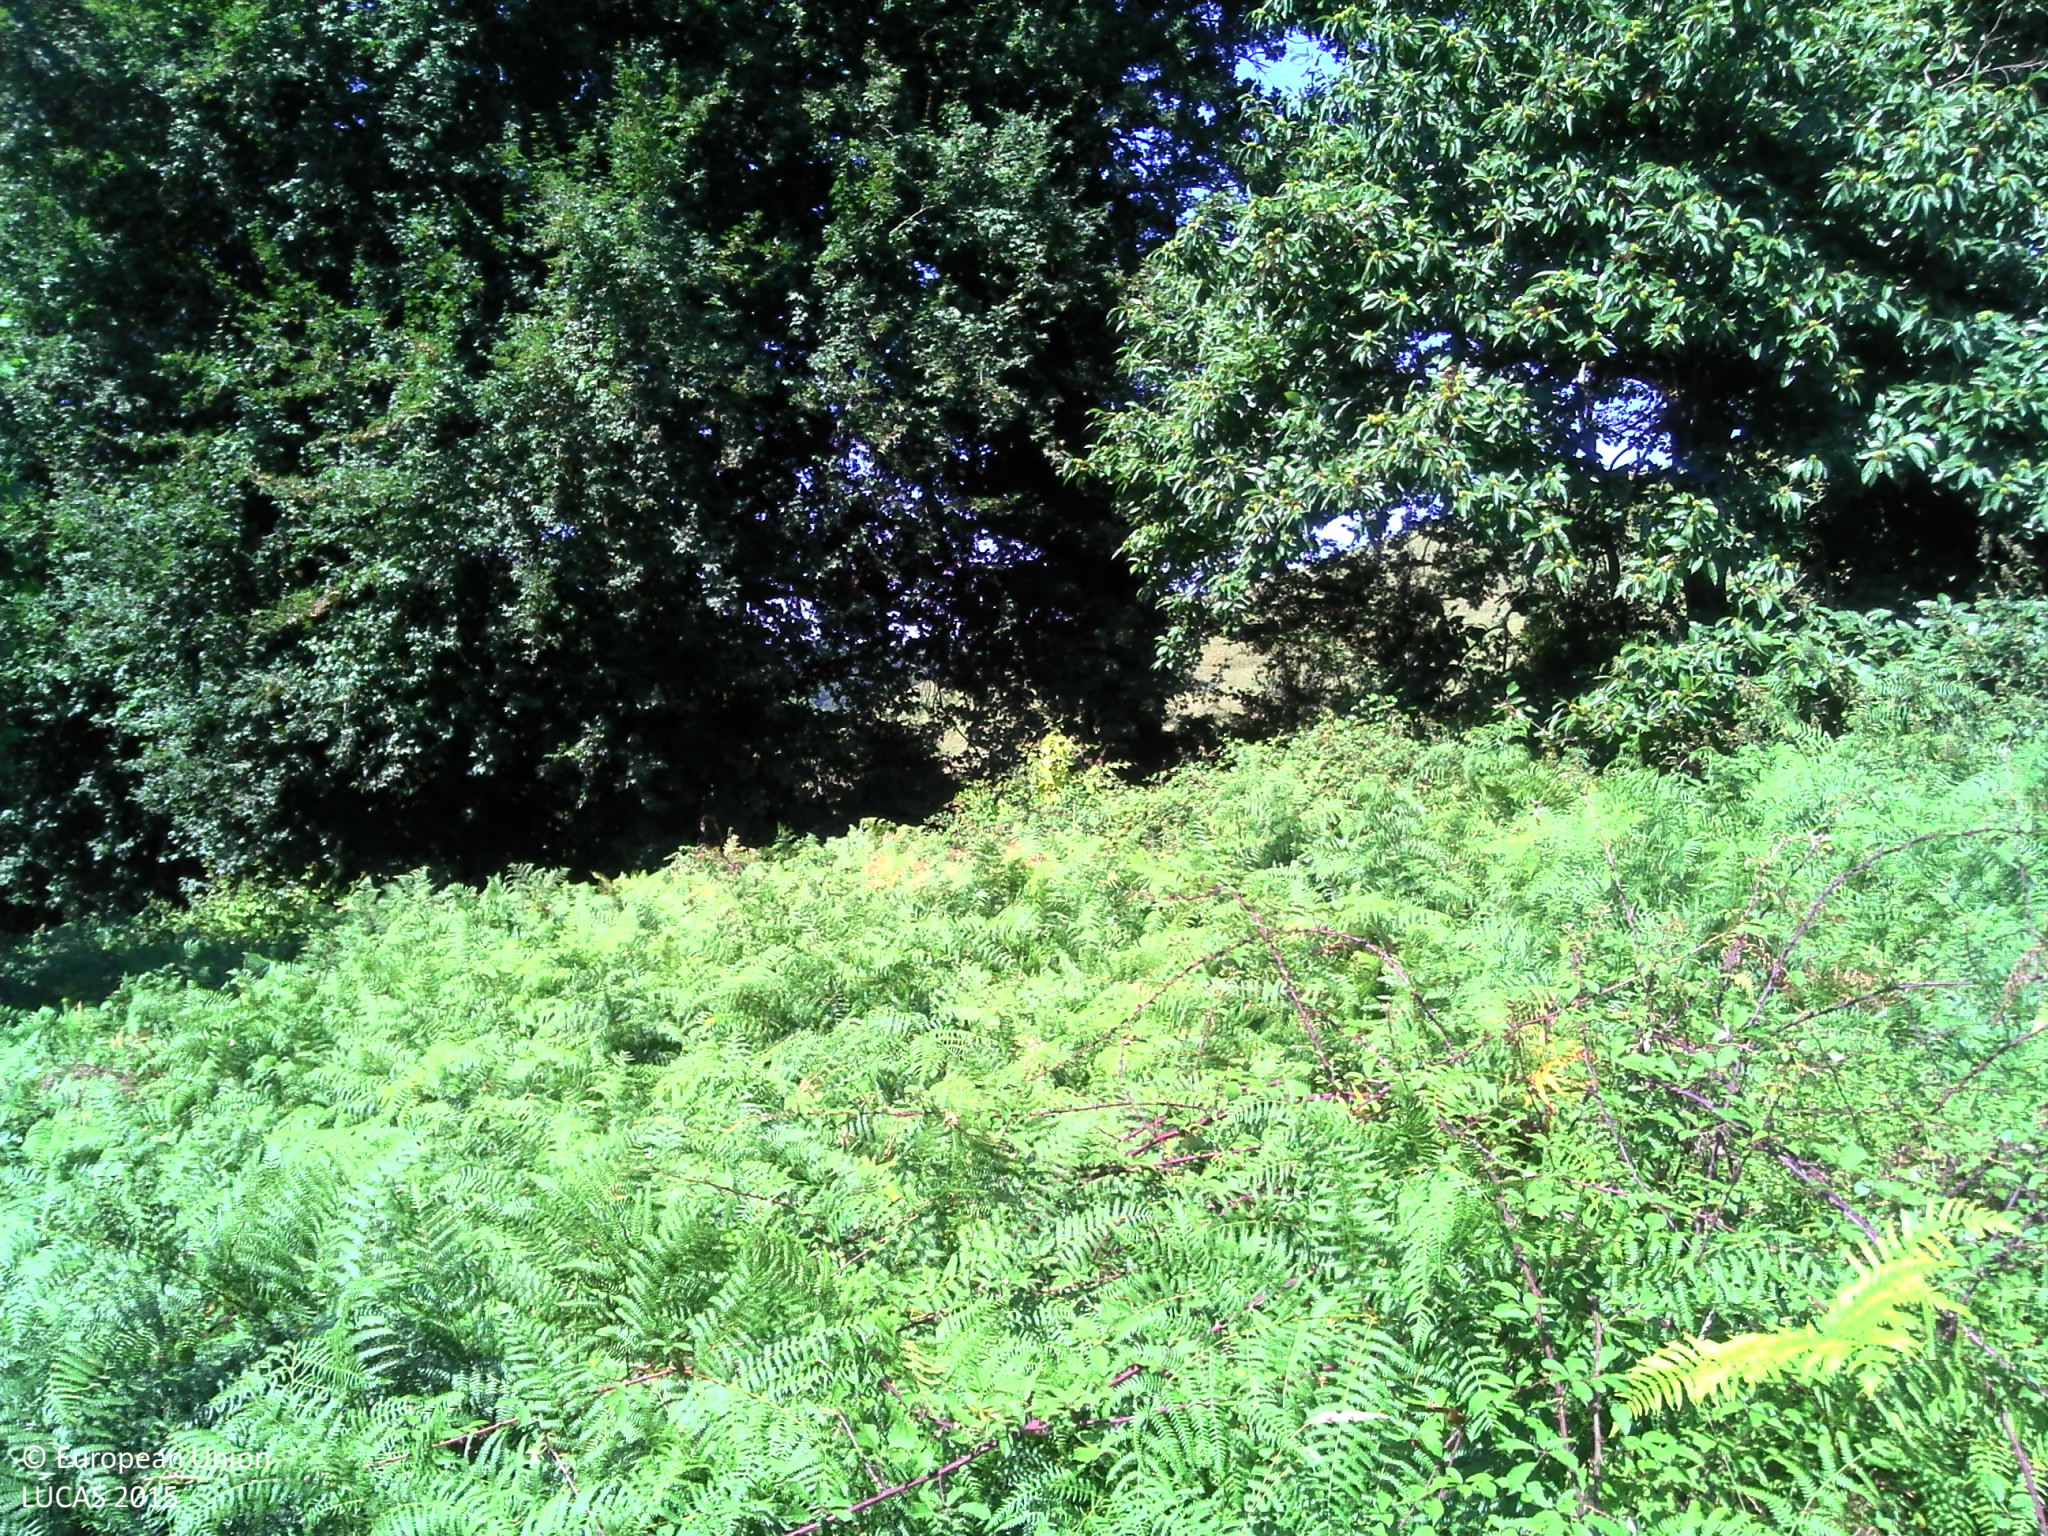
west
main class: Grassland
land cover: Spontaneously vegetated surfaces
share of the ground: > 75 %
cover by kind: herbaceous plants 95 %, shrubs 5 %
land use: Agriculture (excluding fallow land and kitchen gardens)
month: August
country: FR
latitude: 43.4058
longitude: -1.1152
